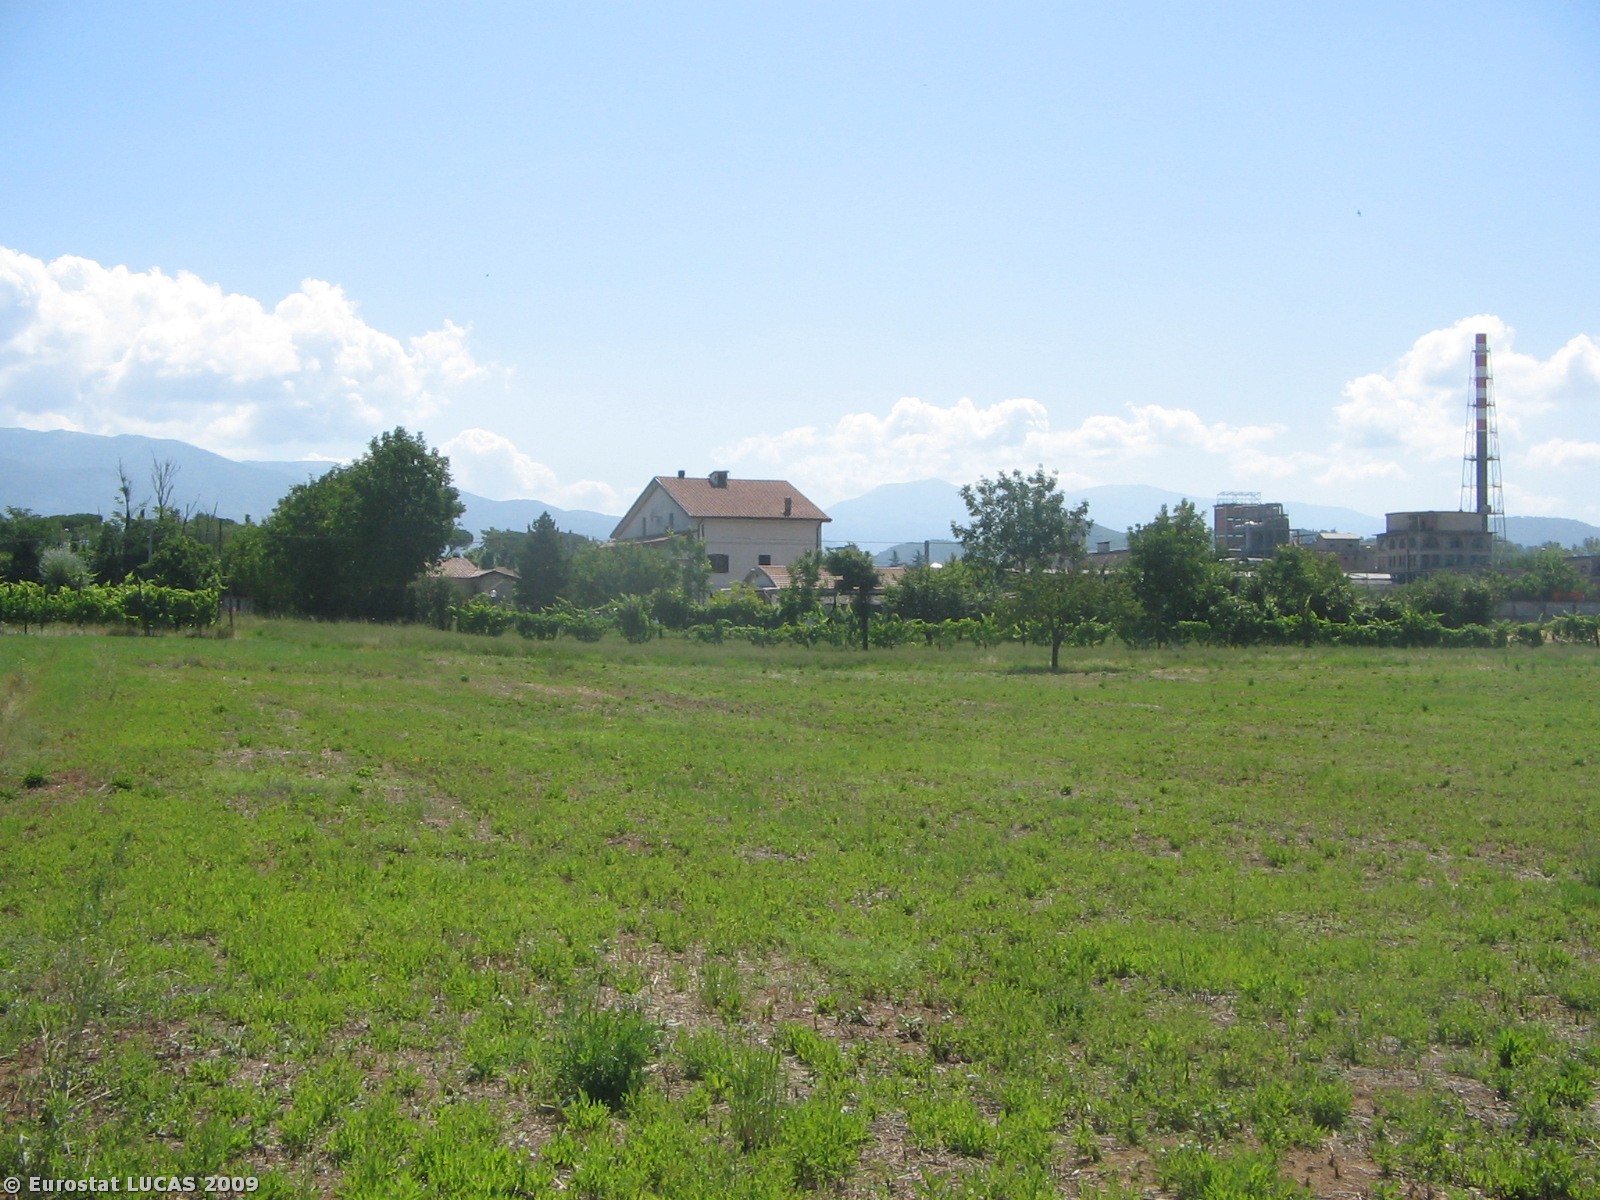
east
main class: Grassland
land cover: Spontaneously vegetated surfaces
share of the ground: > 75 %
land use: Fallow land
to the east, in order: Spontaneously vegetated surfaces; Electric lines; Spontaneously vegetated surfaces; Artificial constructions; Paved roads, cycling and walking lanes; Artificial constructions; Managed hedges; Arable land (only in case pi)
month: July
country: IT
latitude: 42.4152
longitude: 12.8464
